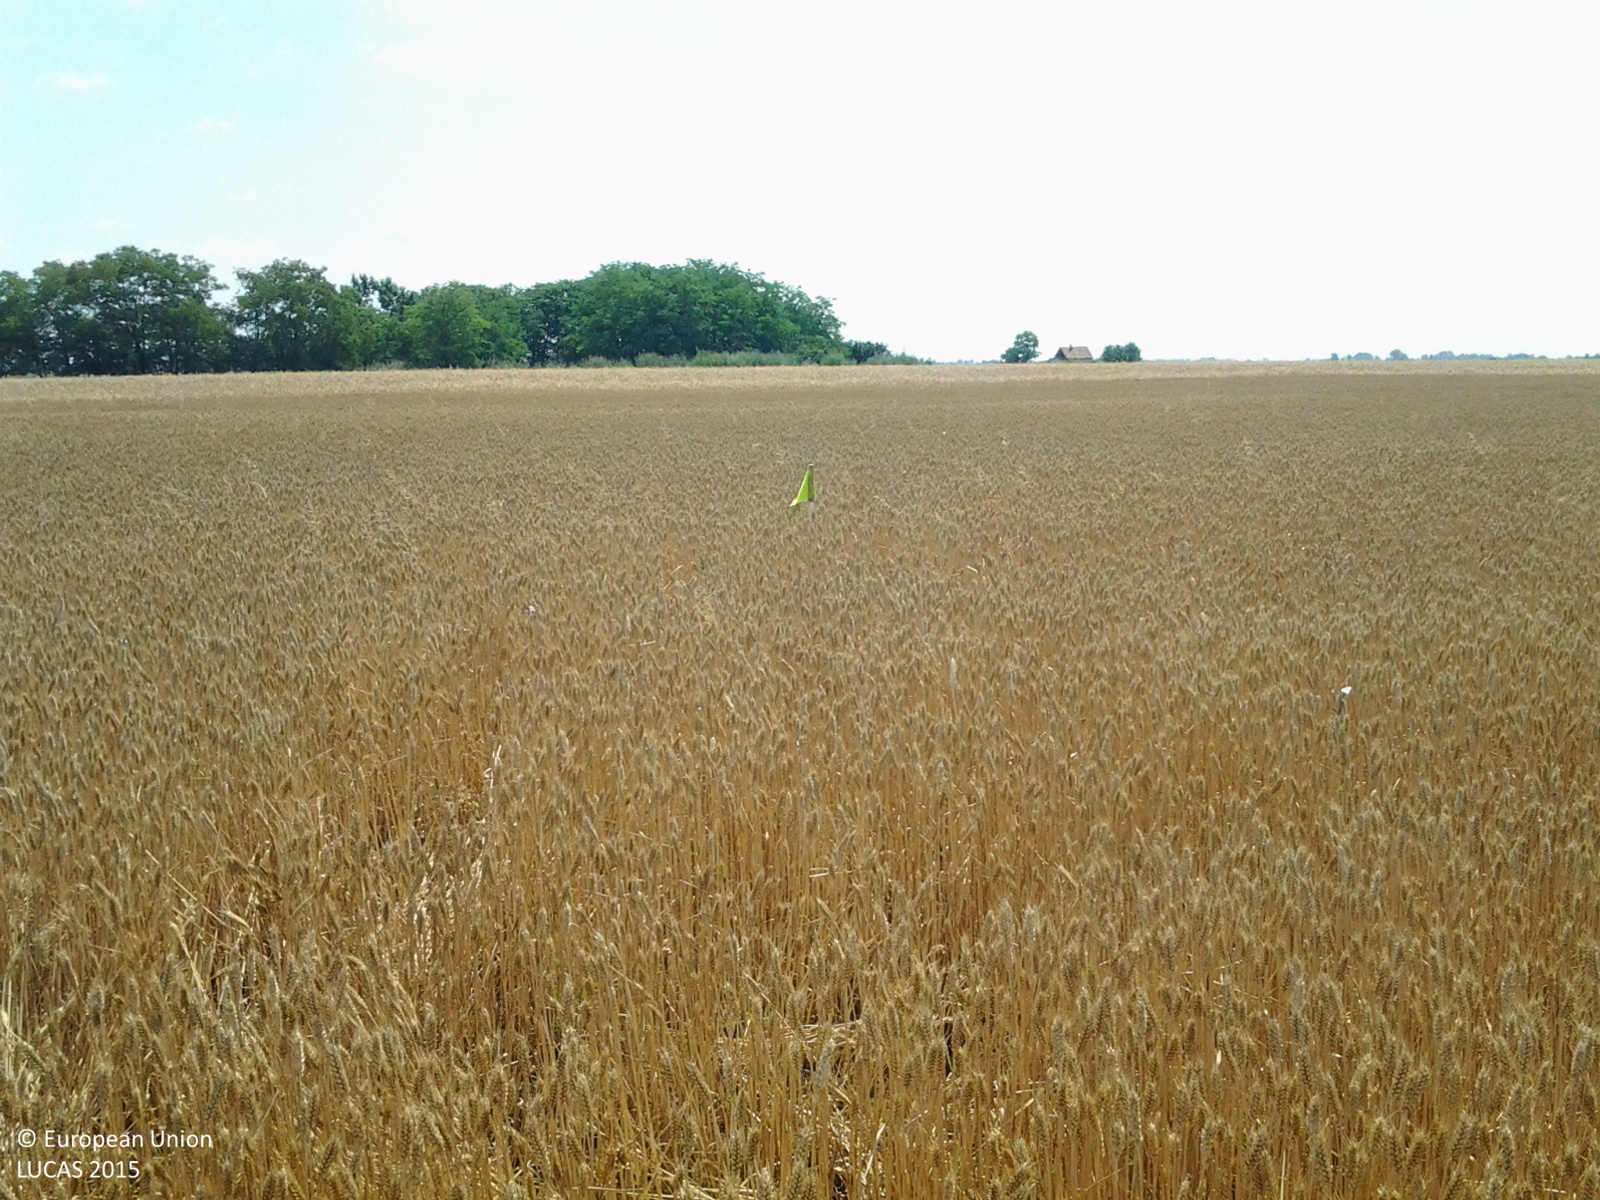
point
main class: Cropland
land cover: Common wheat
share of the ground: > 75 %
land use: Agriculture (excluding fallow land and kitchen gardens)
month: July
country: HU
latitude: 47.5950
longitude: 19.9067
